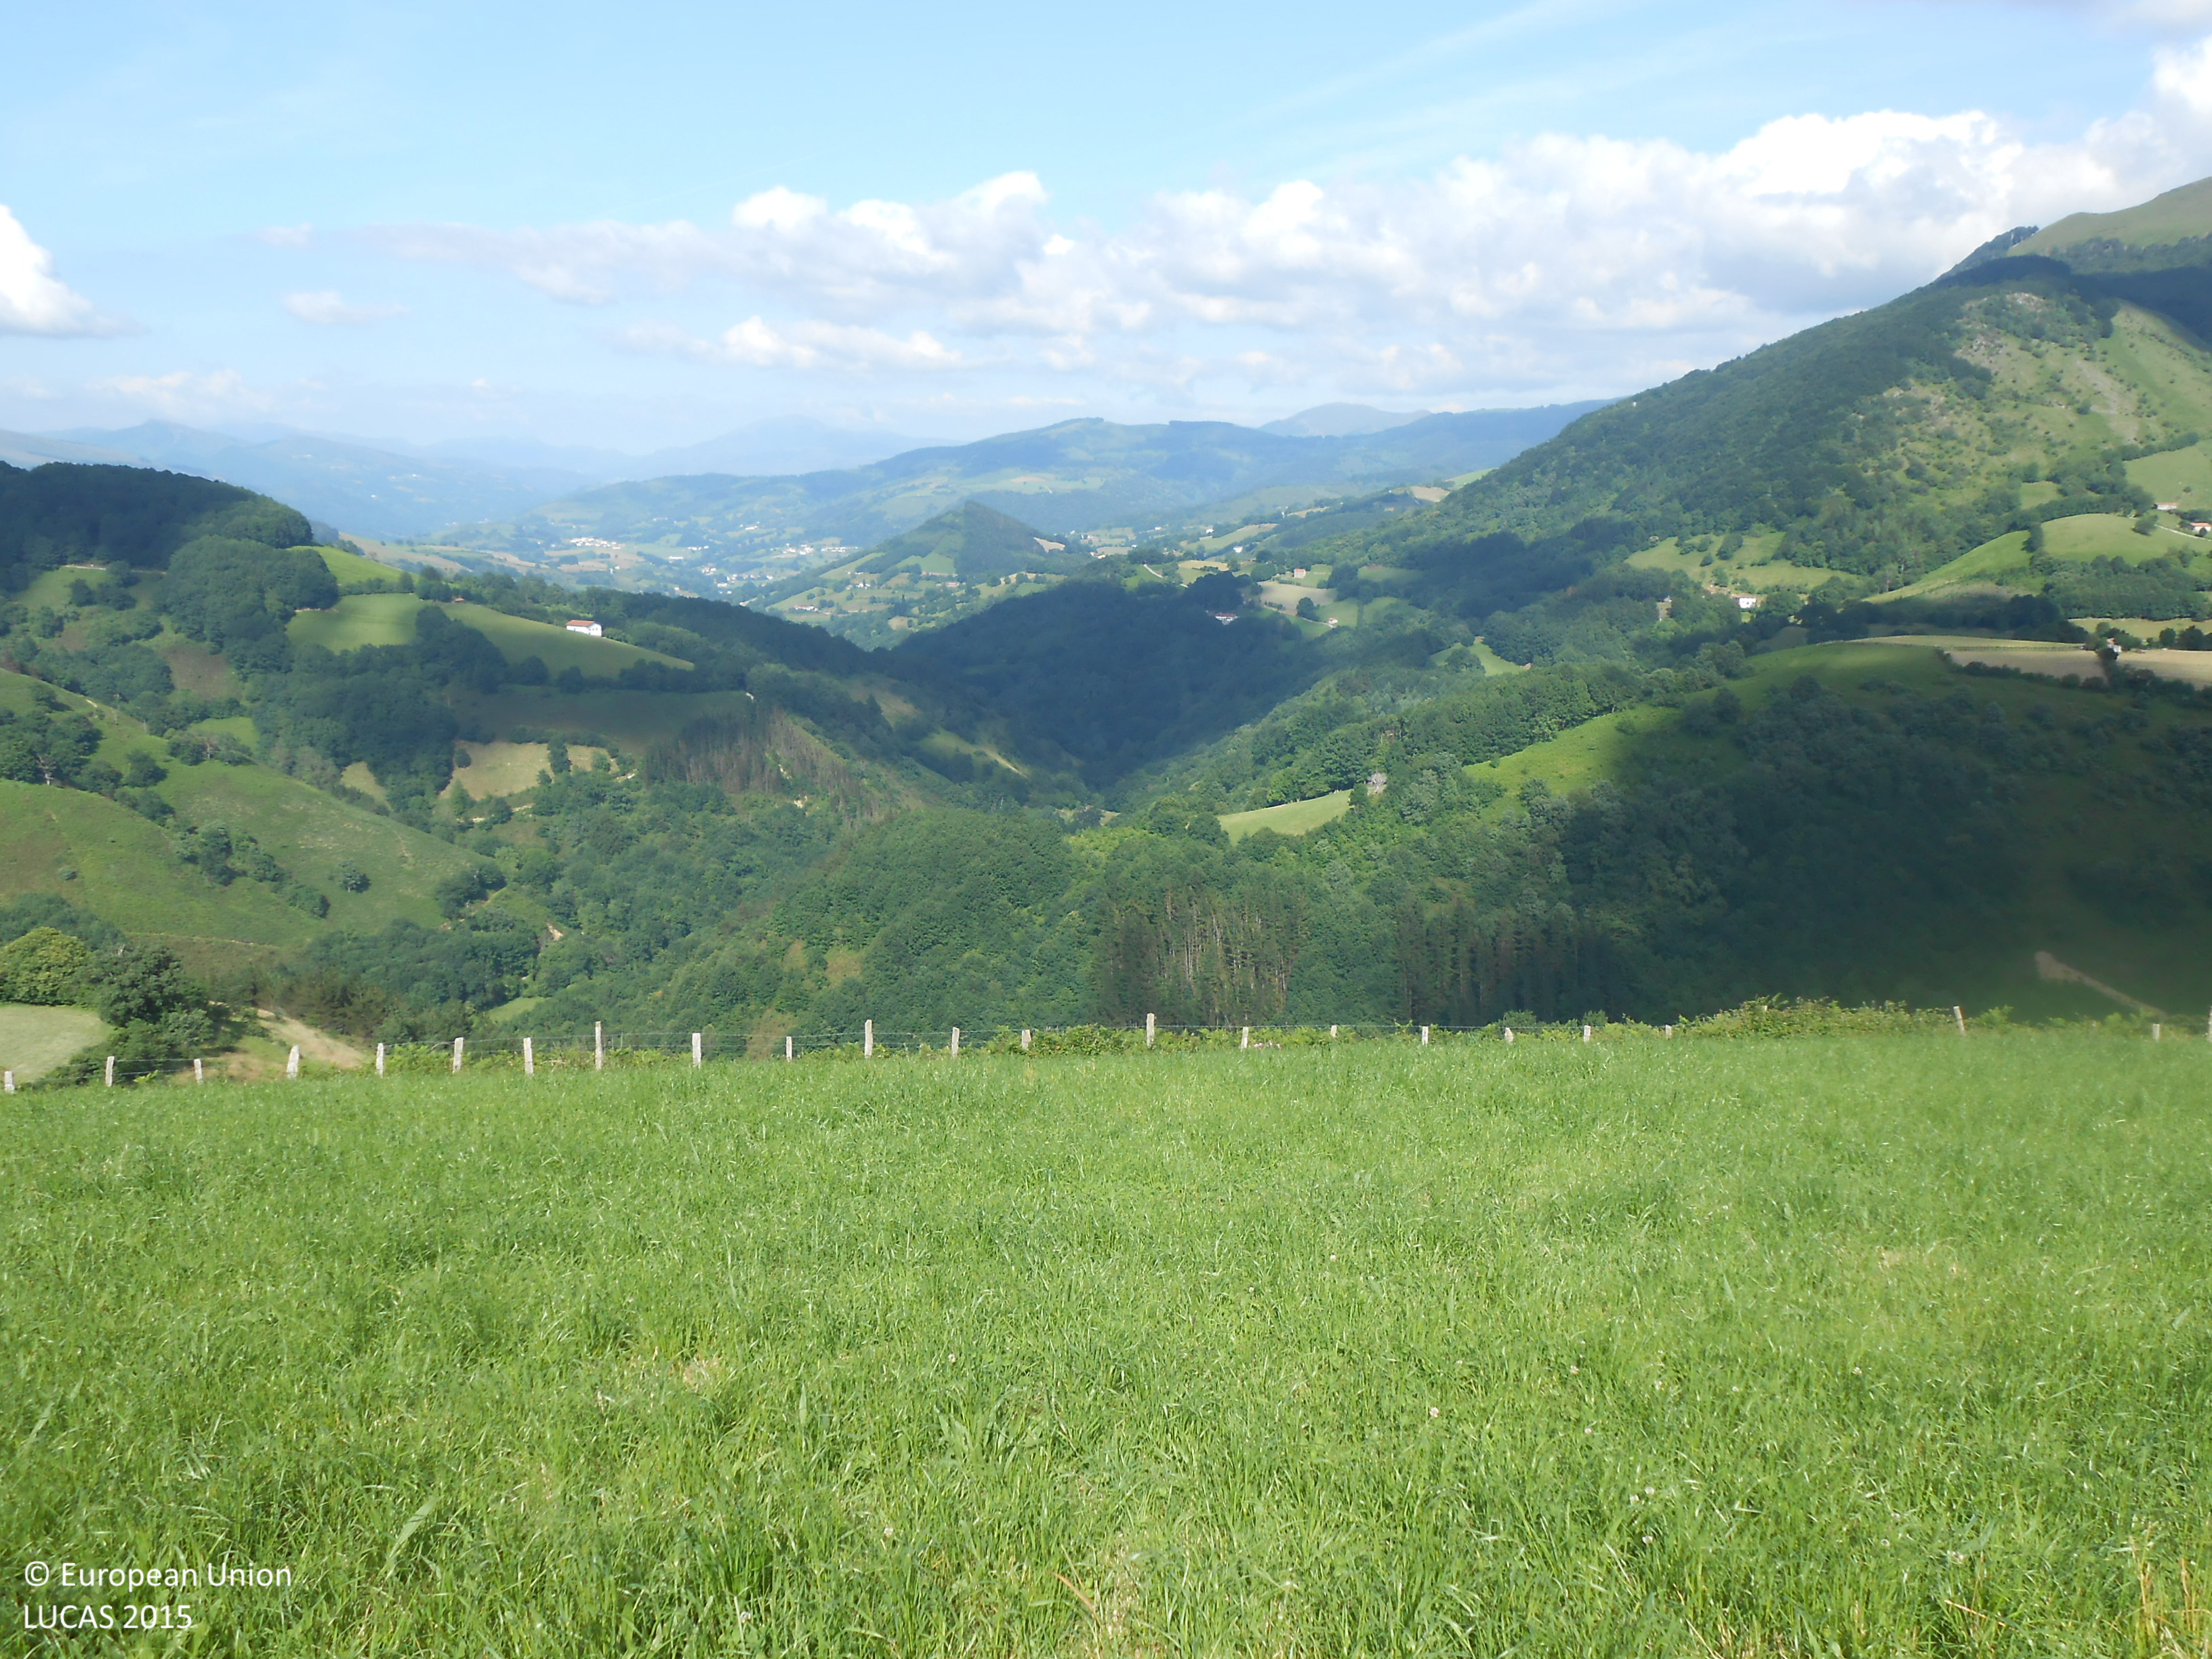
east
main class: Grassland
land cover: Grassland without tree/shrub cover
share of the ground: > 75 %
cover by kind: herbaceous plants 100 %
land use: Agriculture (excluding fallow land and kitchen gardens)
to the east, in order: Grassland without tree/shrub cover; Fences; Grassland without tree/shrub cover; Fences; Grass margins; Tracks; Grass margins; Fences; Broadleaved woodland; Grass margins; Tracks; Broadleaved woodland
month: June
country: ES
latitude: 43.0975
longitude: -1.7514
